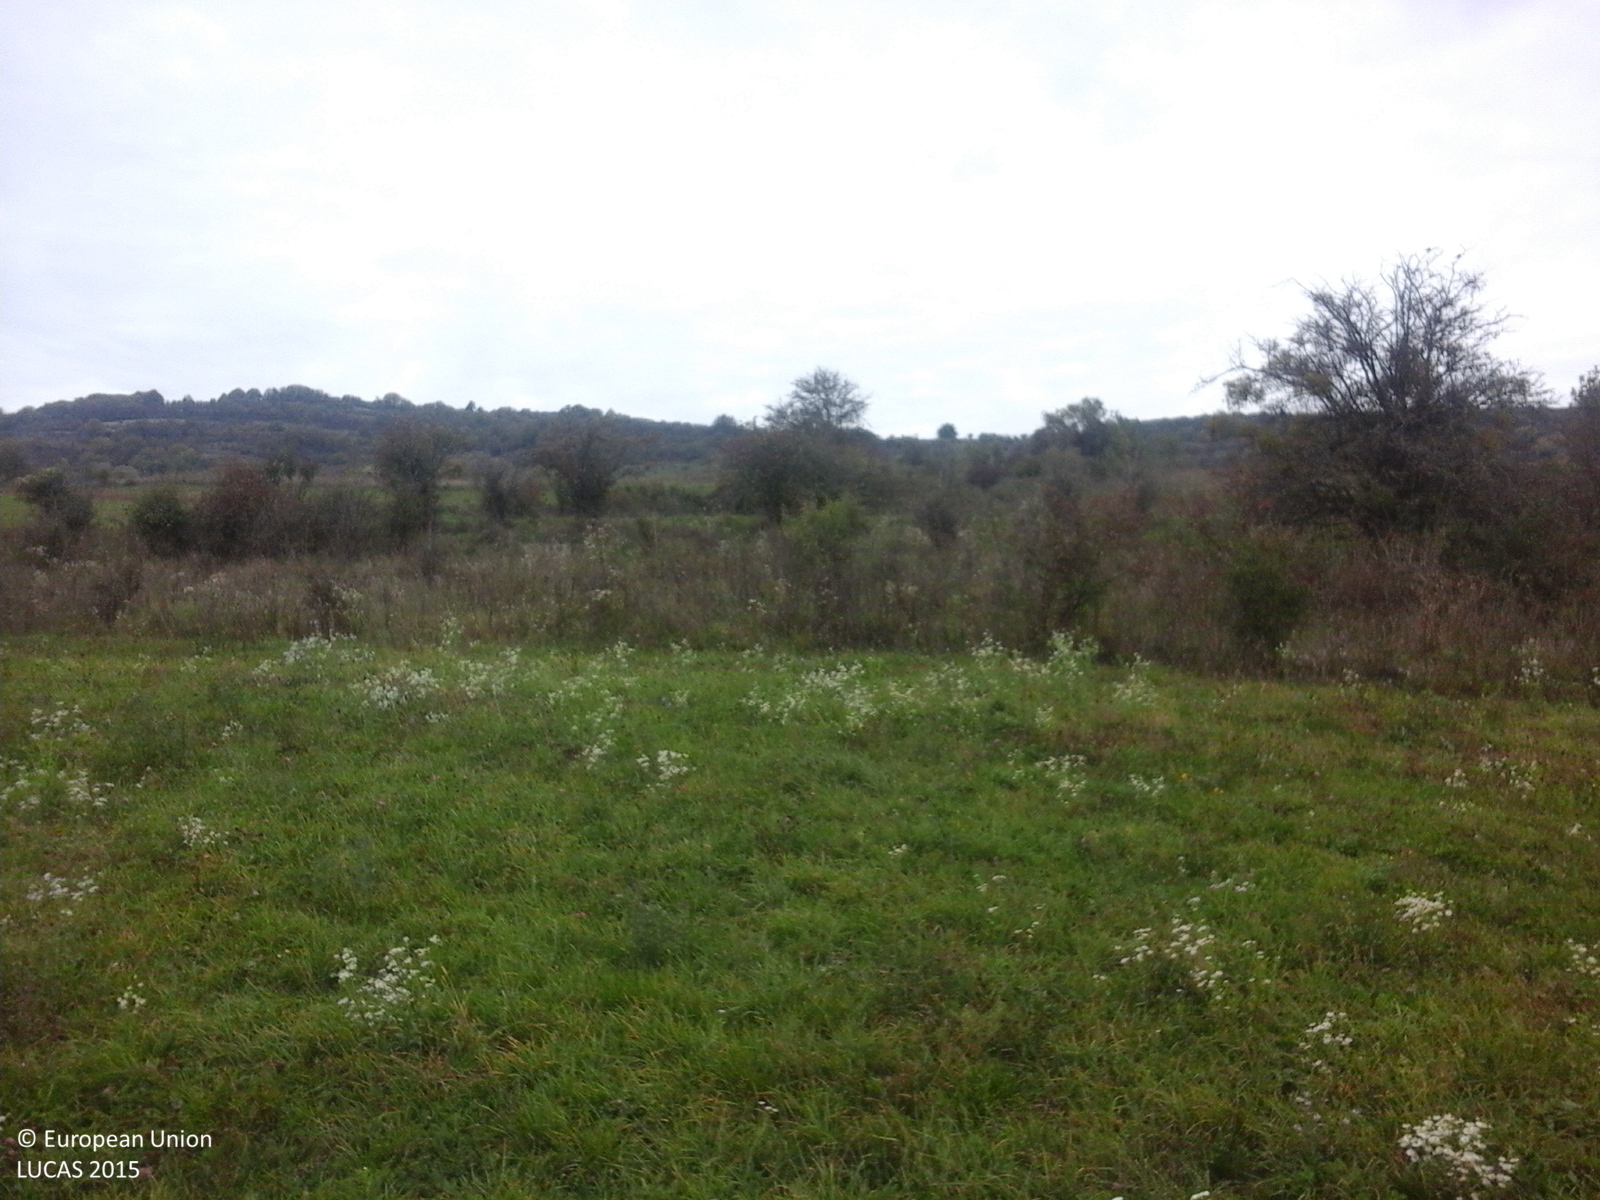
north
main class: Grassland
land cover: Grassland without tree/shrub cover
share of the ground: > 75 %
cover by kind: herbaceous plants 100 %
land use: Agriculture (excluding fallow land and kitchen gardens)
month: October
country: RO
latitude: 46.2658
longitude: 25.1895
